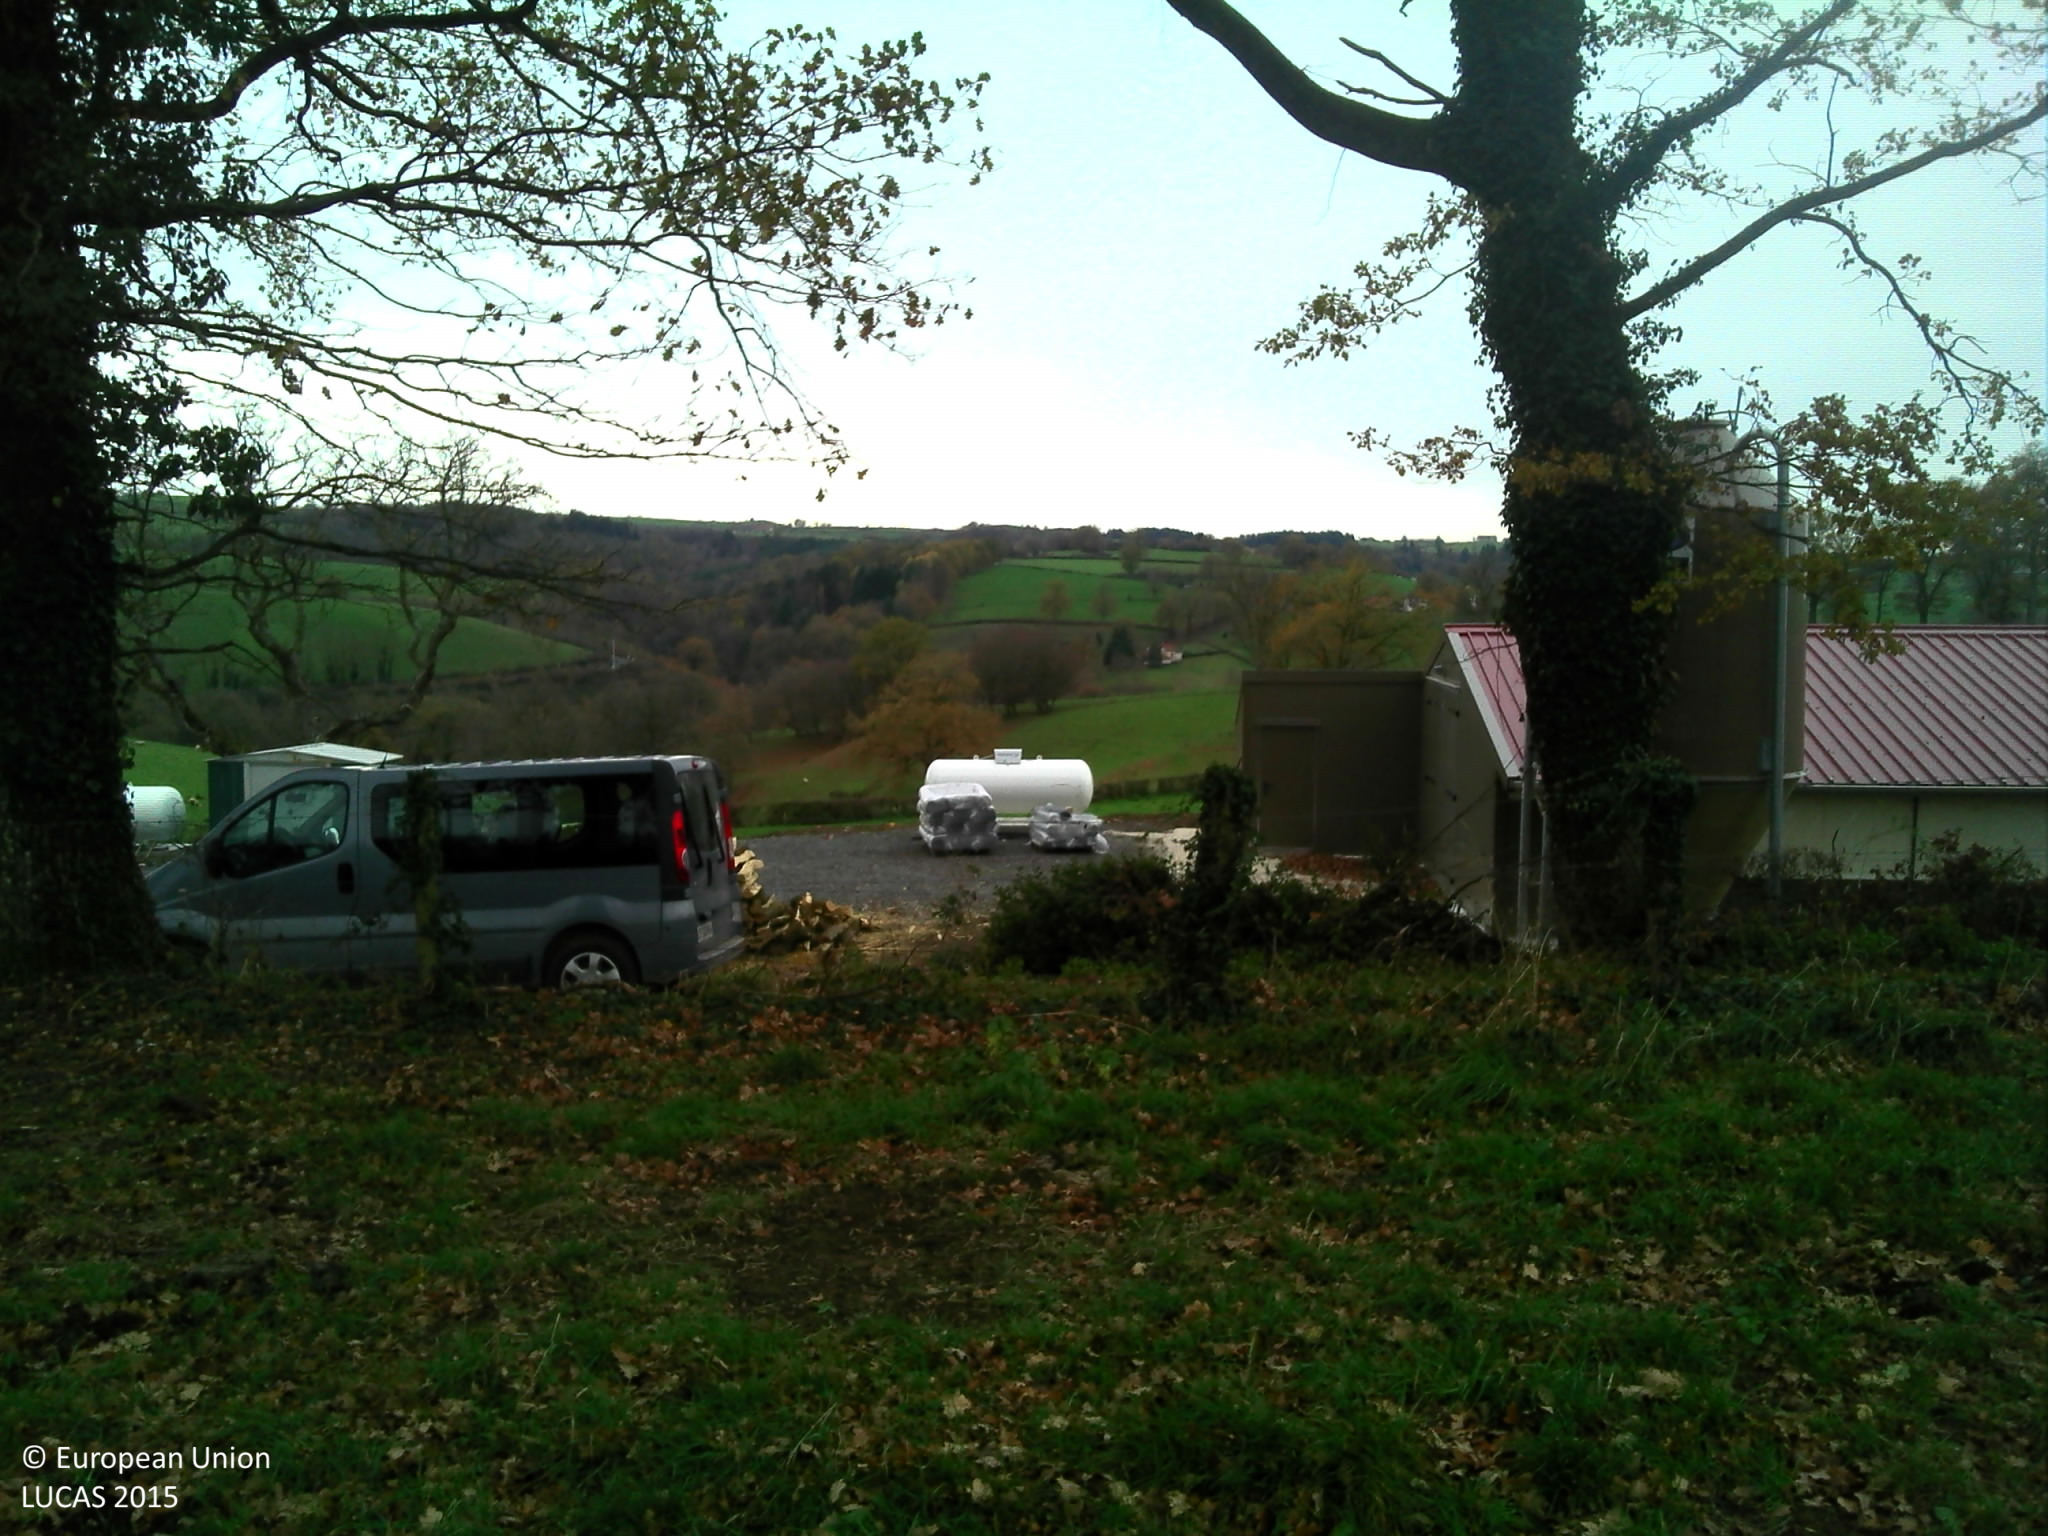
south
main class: Grassland
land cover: Grassland without tree/shrub cover
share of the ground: > 75 %
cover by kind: herbaceous plants 100 %
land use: Agriculture (excluding fallow land and kitchen gardens)
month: November
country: FR
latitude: 46.3280
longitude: 3.7001
